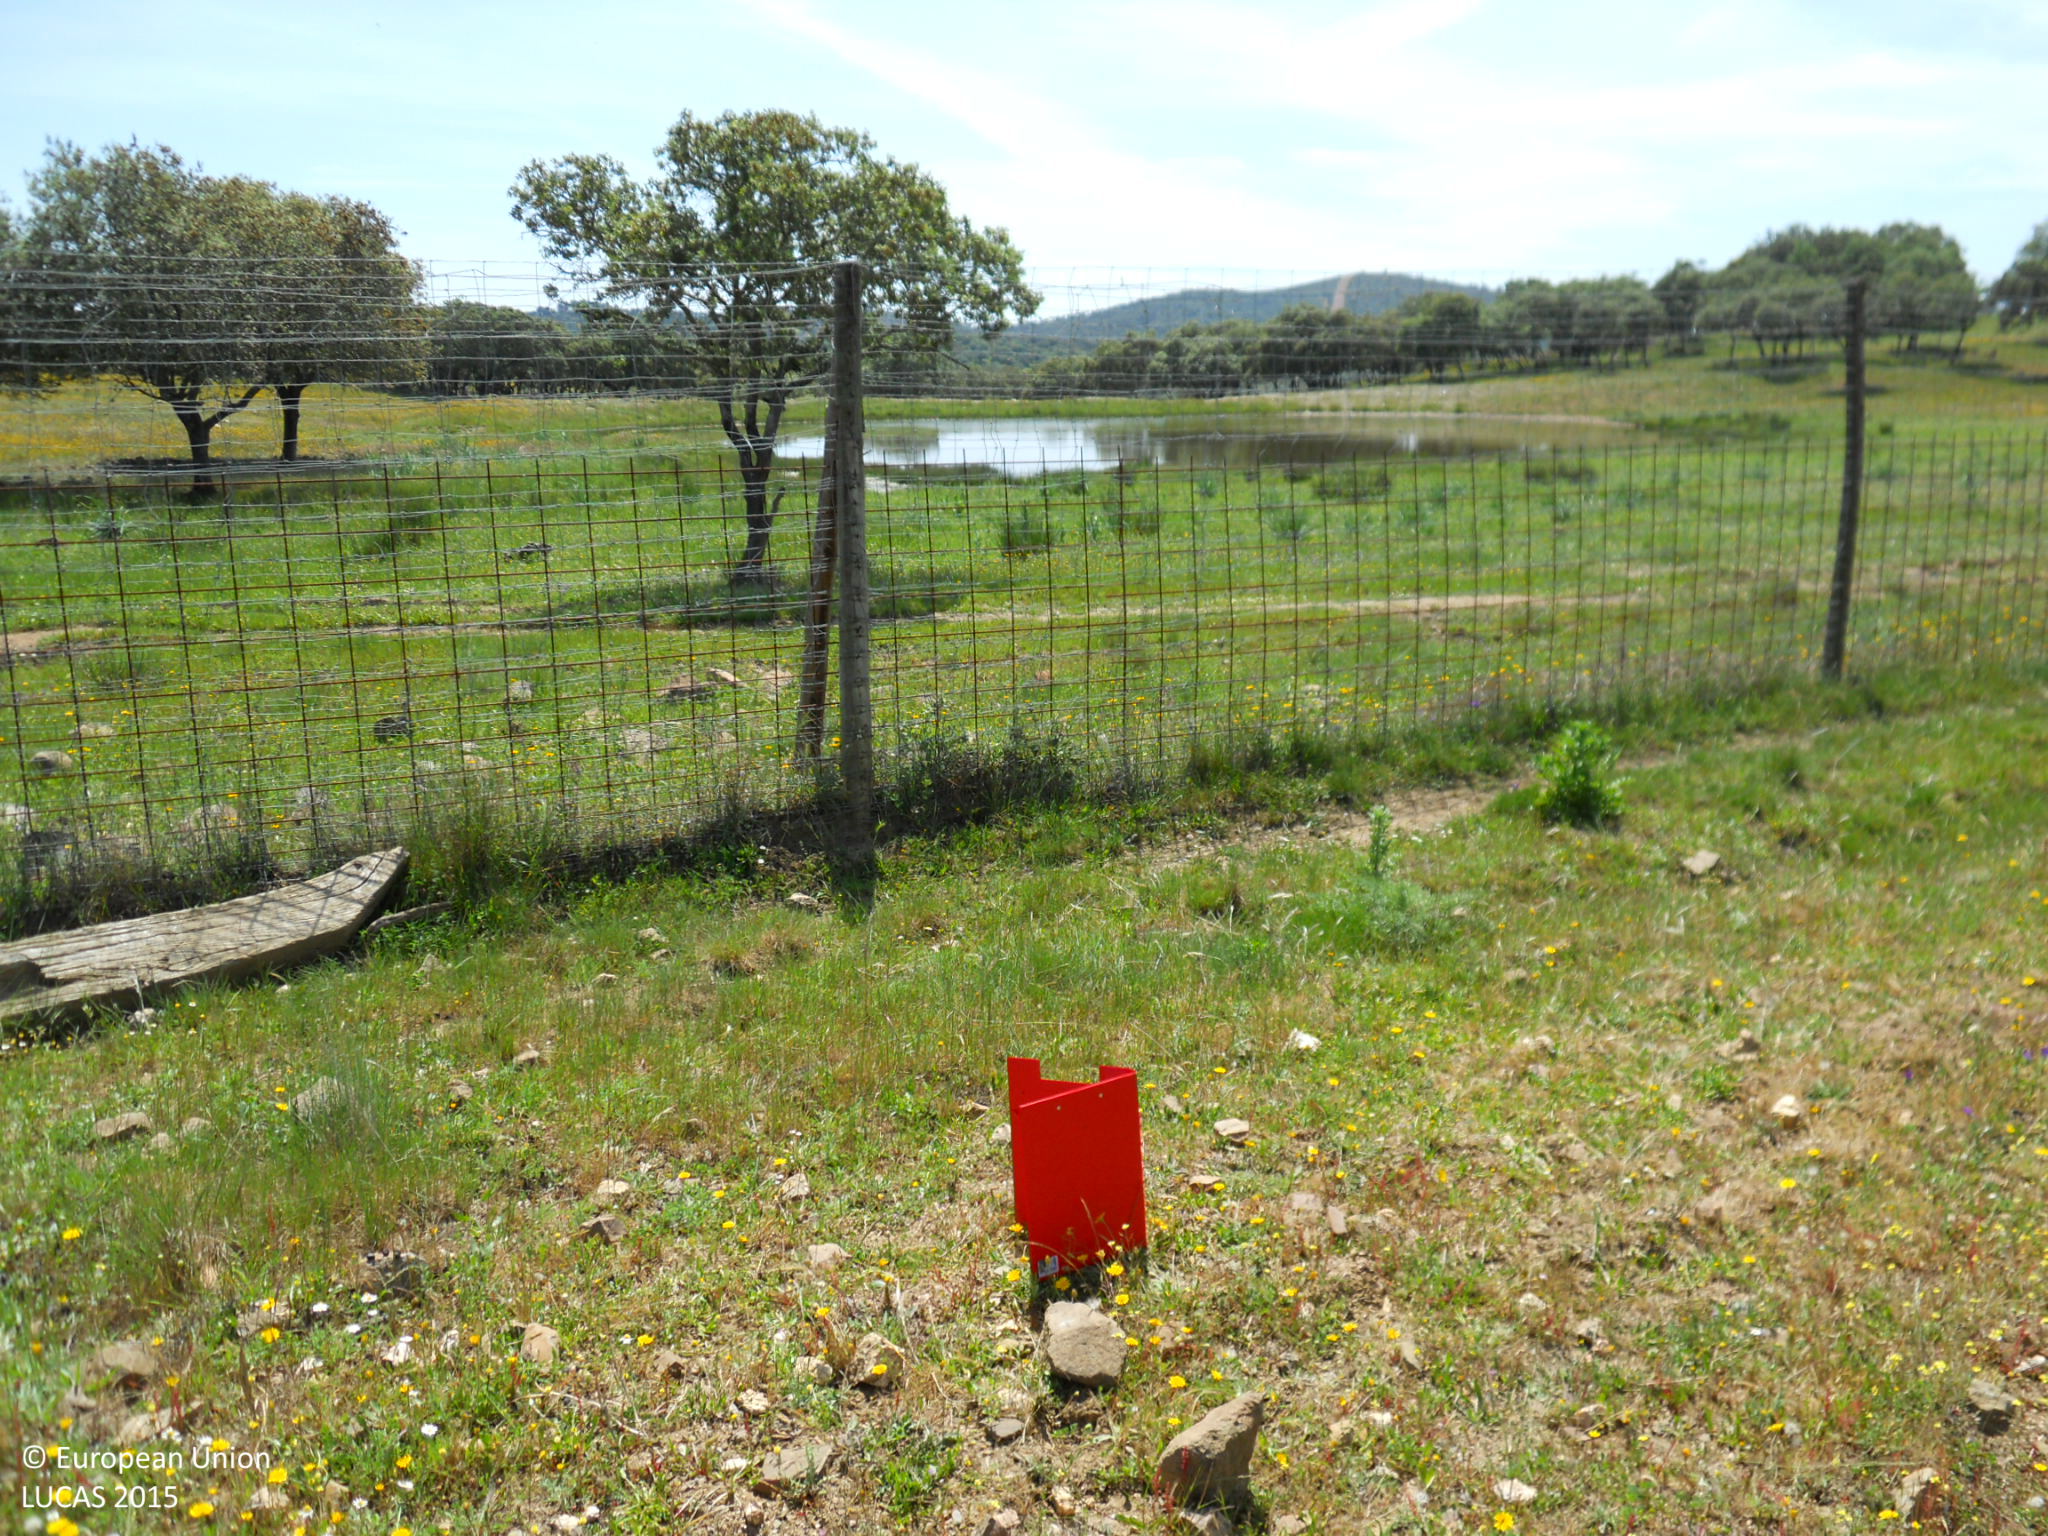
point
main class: Grassland
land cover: Grassland with sparse tree/shrub cover
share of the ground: > 75 %
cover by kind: herbaceous plants 90 %, broadleaved forest trees 5 %, shrubs 5 %
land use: Agriculture (excluding fallow land and kitchen gardens)
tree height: < 5 m
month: April
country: ES
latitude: 39.1680
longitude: -6.8433
